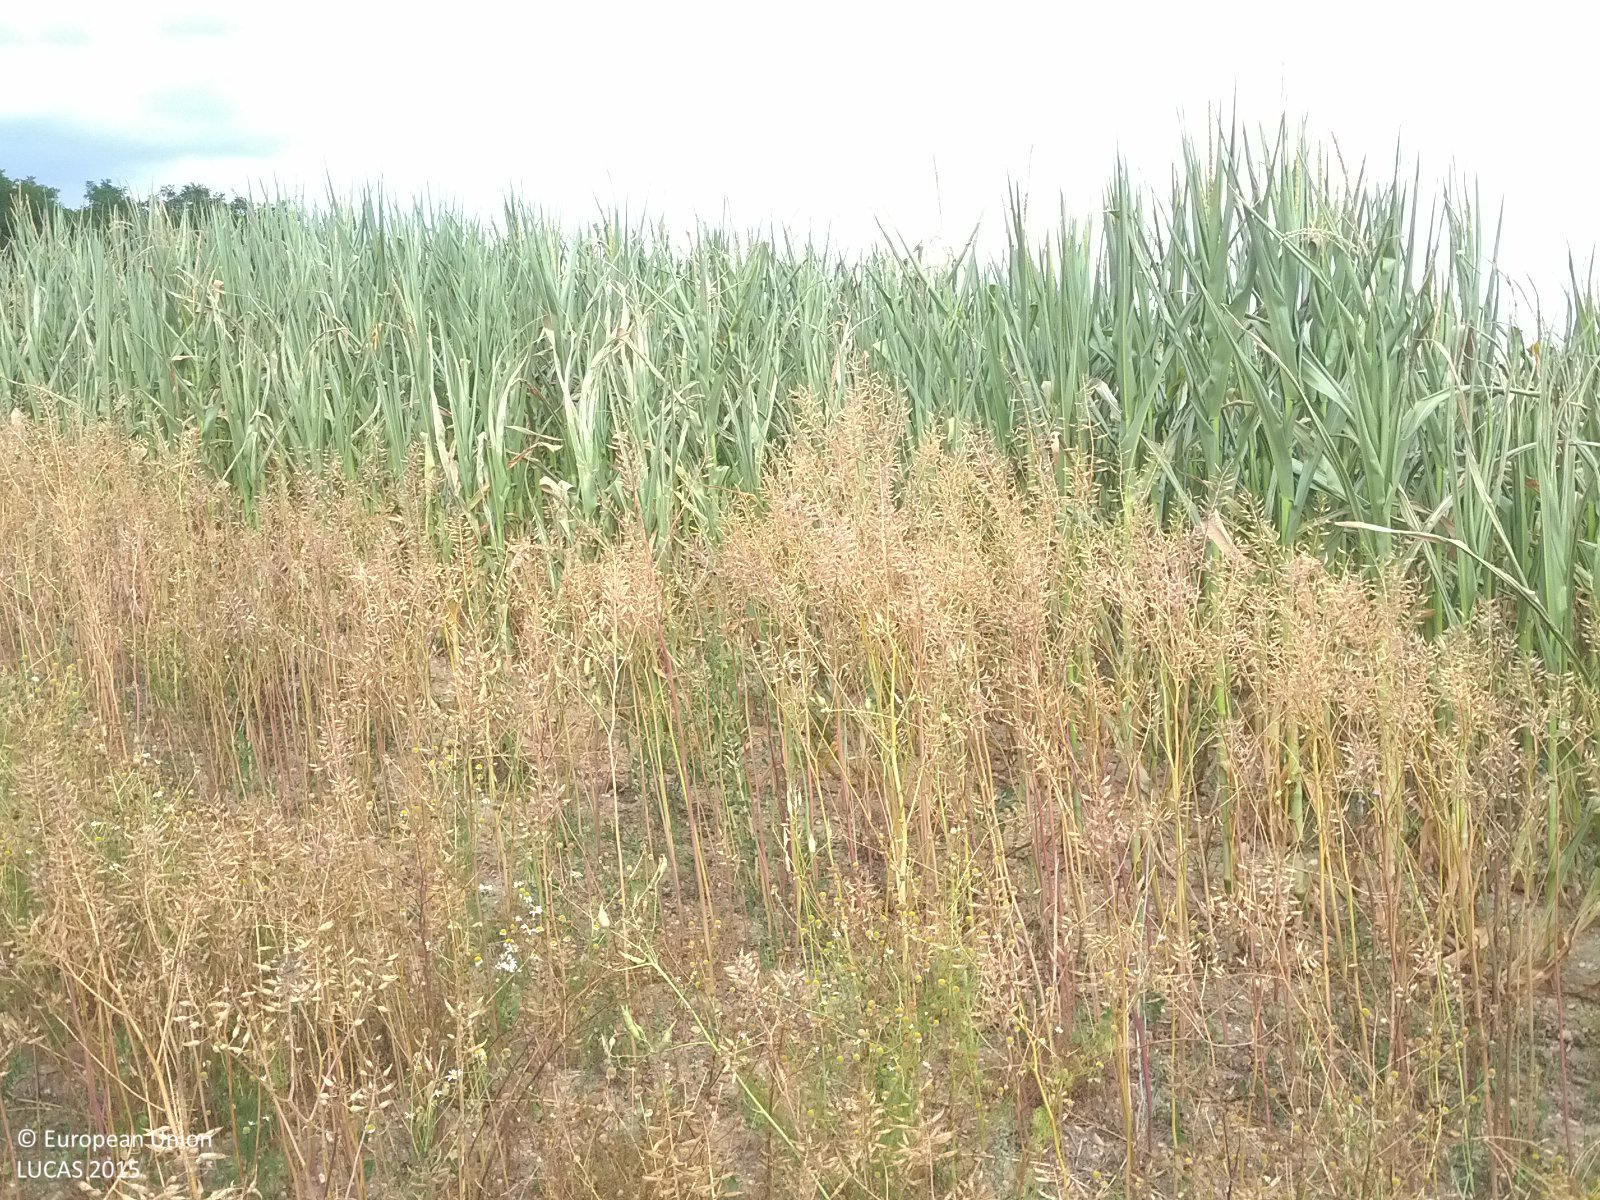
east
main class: Cropland
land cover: Other fibre and oleaginous crops
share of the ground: > 75 %
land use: Agriculture (excluding fallow land and kitchen gardens)
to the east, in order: Other fibre and oleaginous crops; Maize; Grass margins; Tracks; Broadleaved woodland; Tracks; Broadleaved woodland; Other bare soil; Temporary grasslands
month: July
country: AT
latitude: 48.4111
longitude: 16.1788
